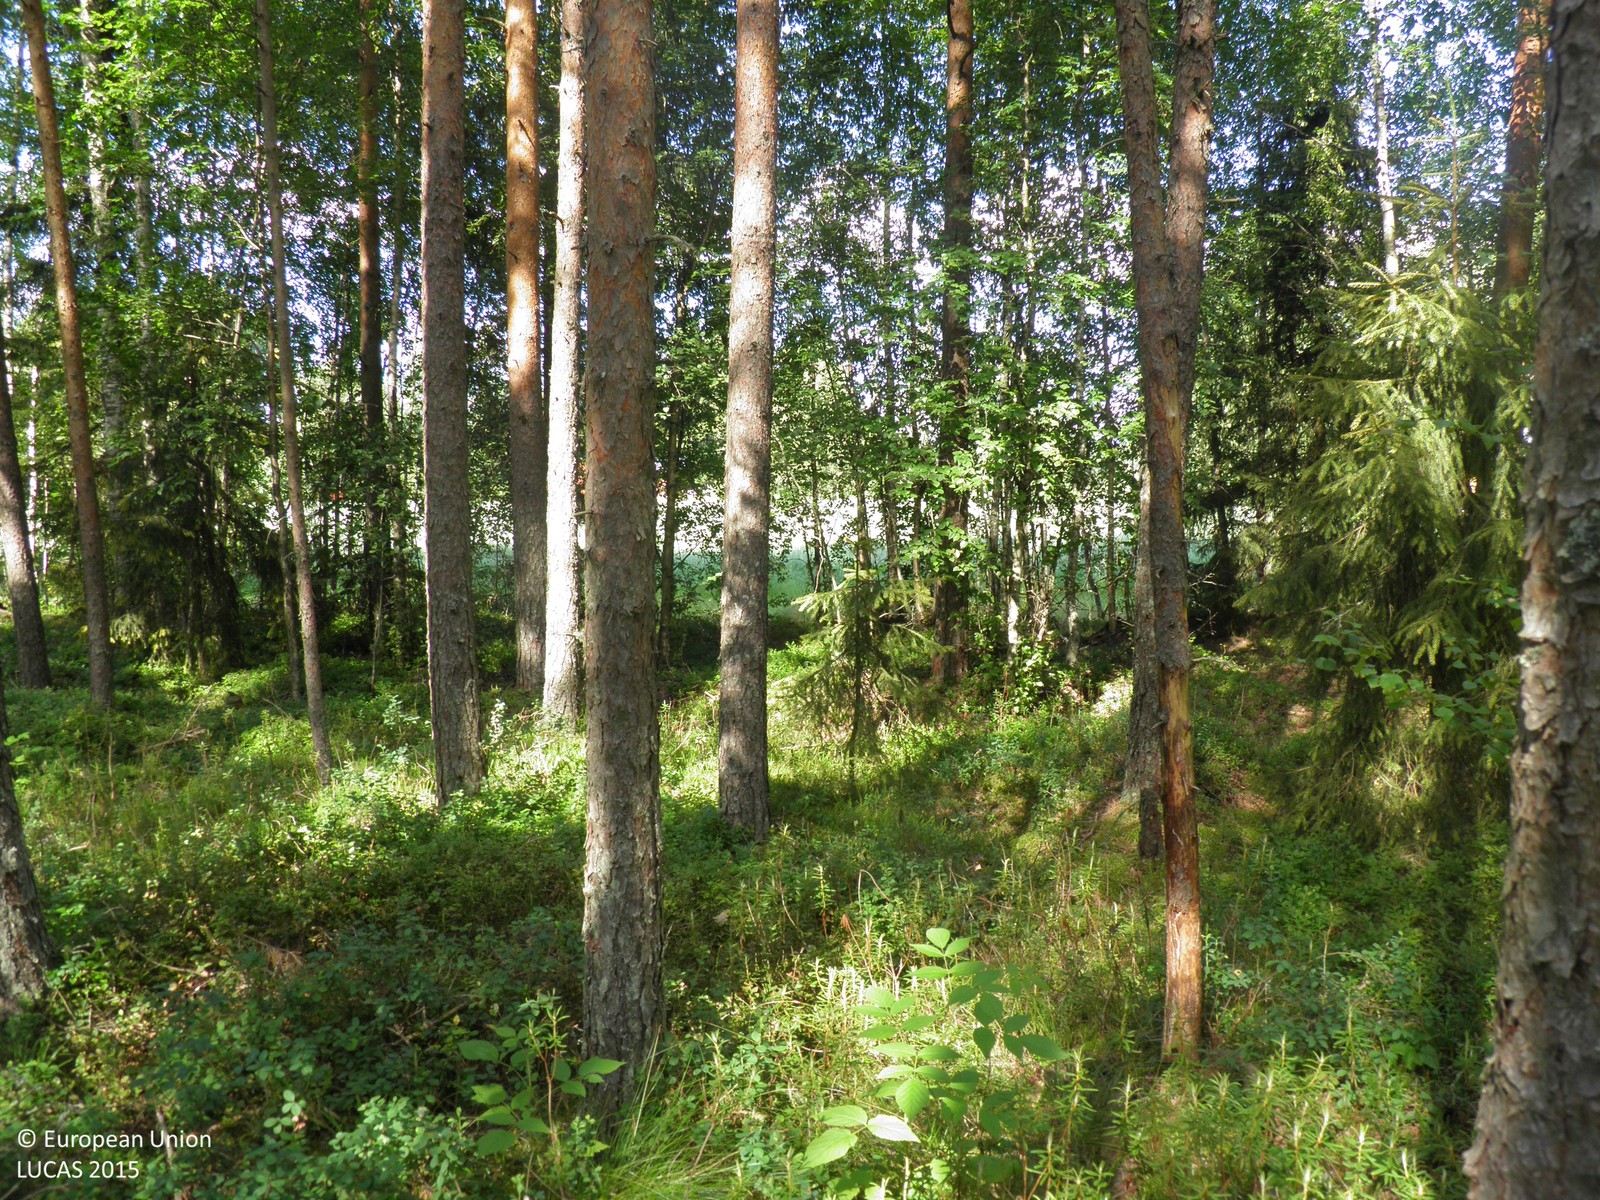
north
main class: Woodland
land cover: Pine dominated coniferous woodland
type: hemiboreal forest and nemoral coniferous forest and mixed broadleaved-coniferous forest
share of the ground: > 75 %
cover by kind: coniferous forest trees 75 %, shrubs 10 %, broadleaved forest trees 5 %, herbaceous plants 5 %, lichens and mosses 5 %
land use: Forestry
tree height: > 5 m
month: August
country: FI
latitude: 61.0099
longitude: 23.1166
